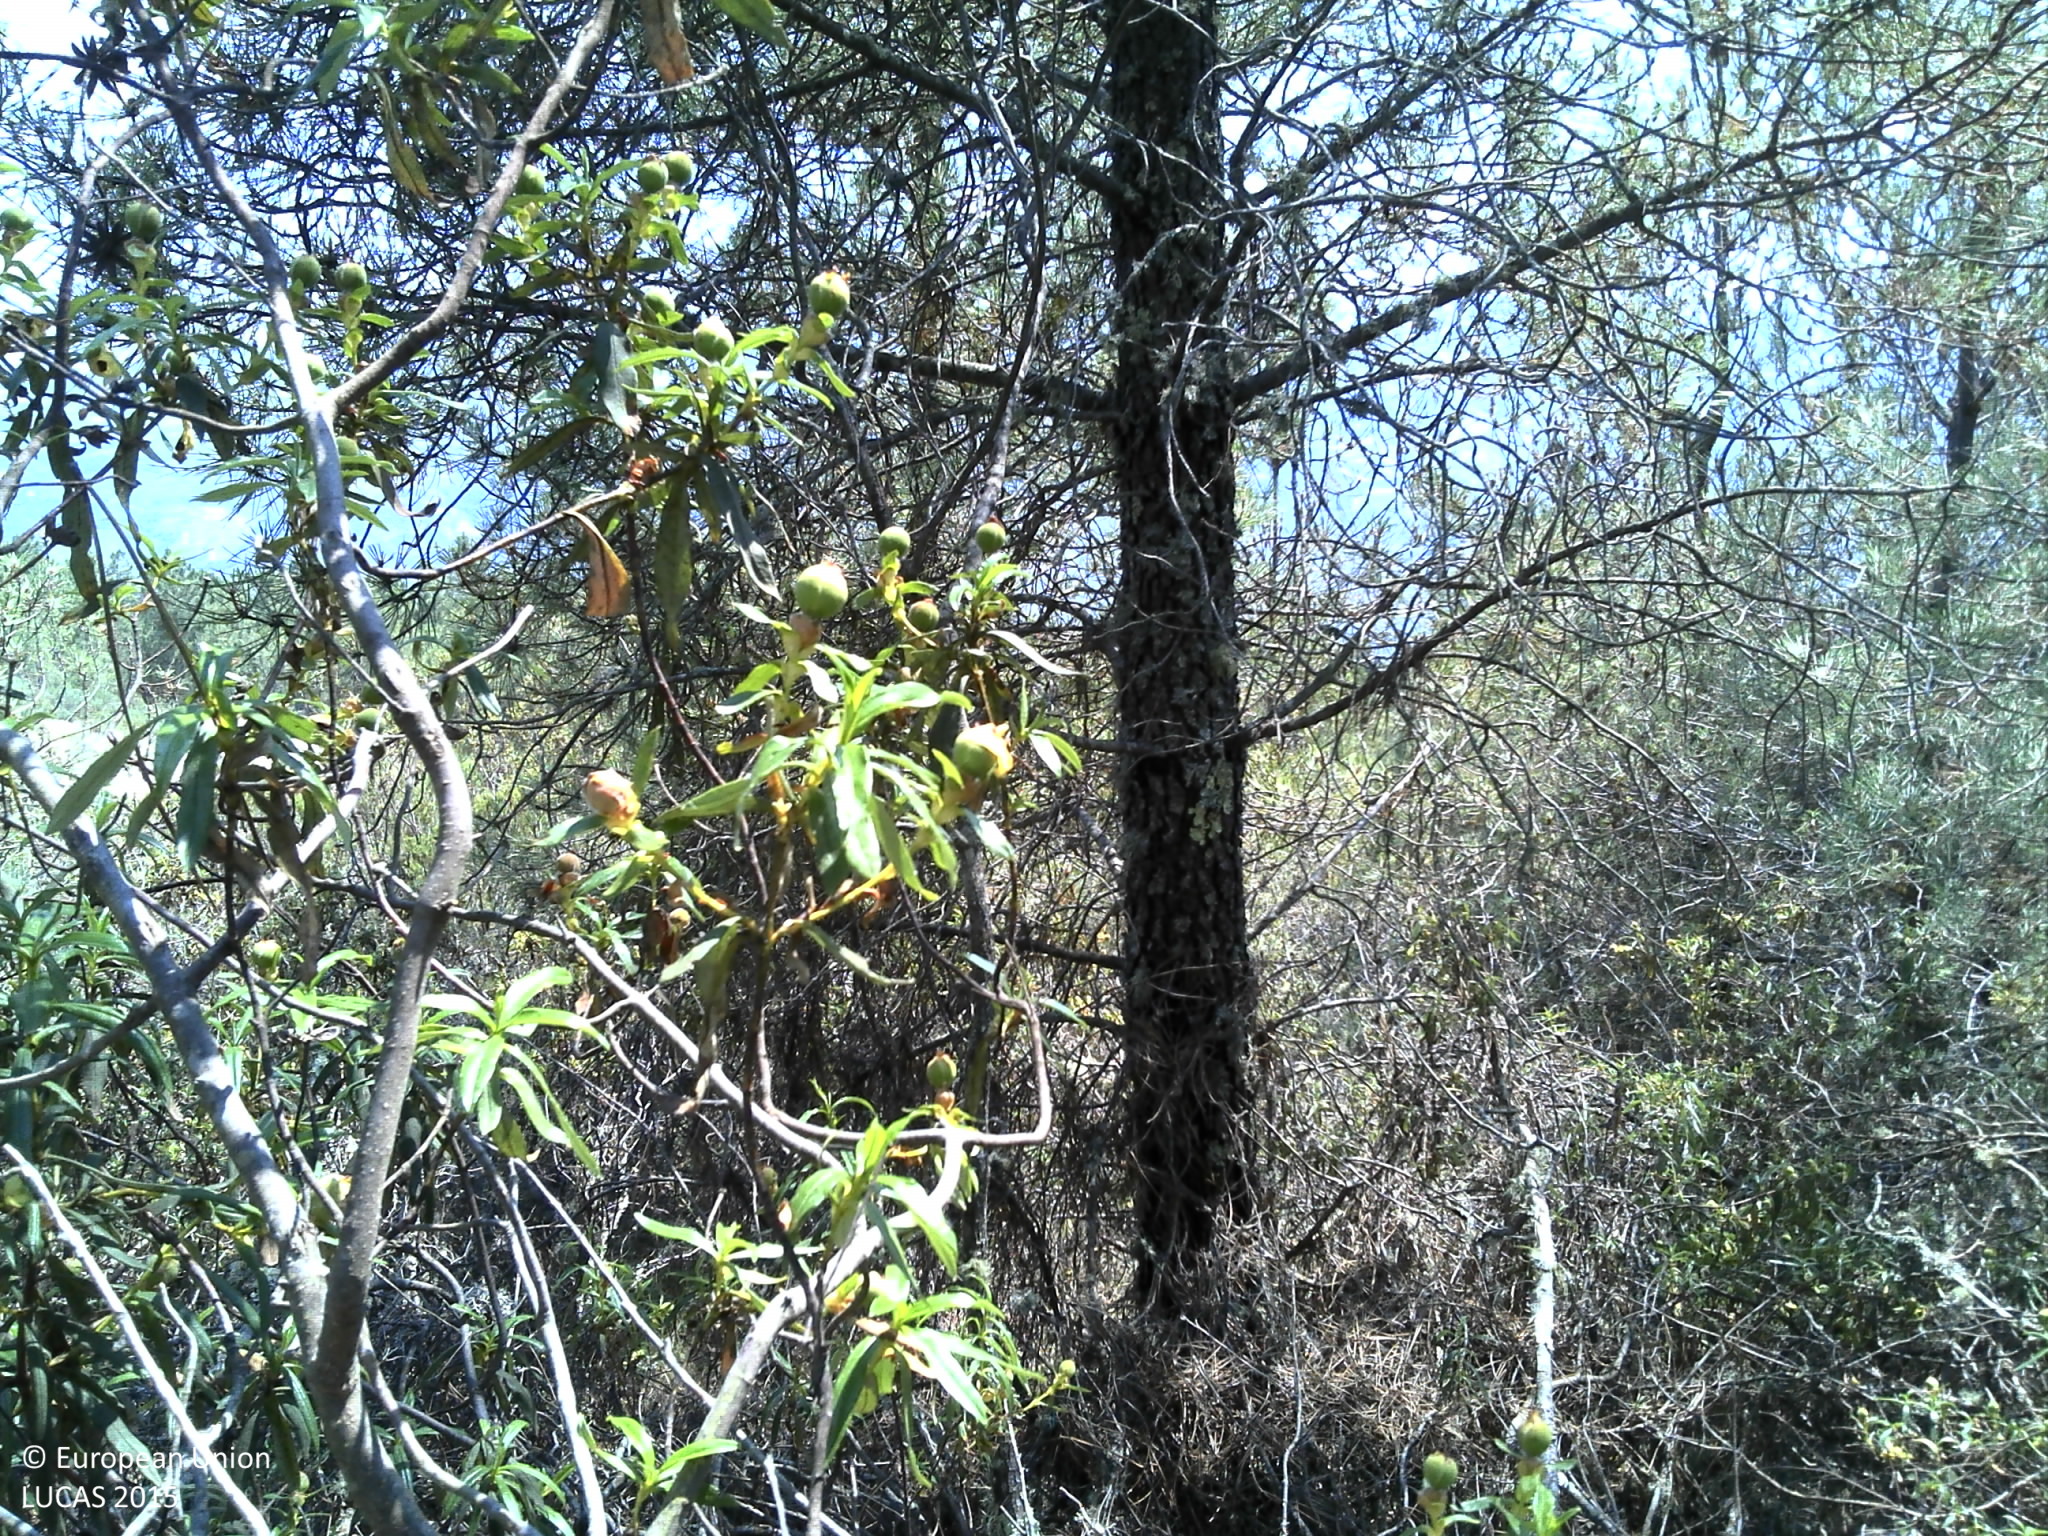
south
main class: Woodland
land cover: Pine dominated coniferous woodland
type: coniferous forest of the mediterranean region
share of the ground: 10 - 25 %
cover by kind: shrubs 80 %, coniferous forest trees 20 %
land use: Forestry
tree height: > 5 m
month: June
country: PT
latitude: 41.1879
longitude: -7.6155
